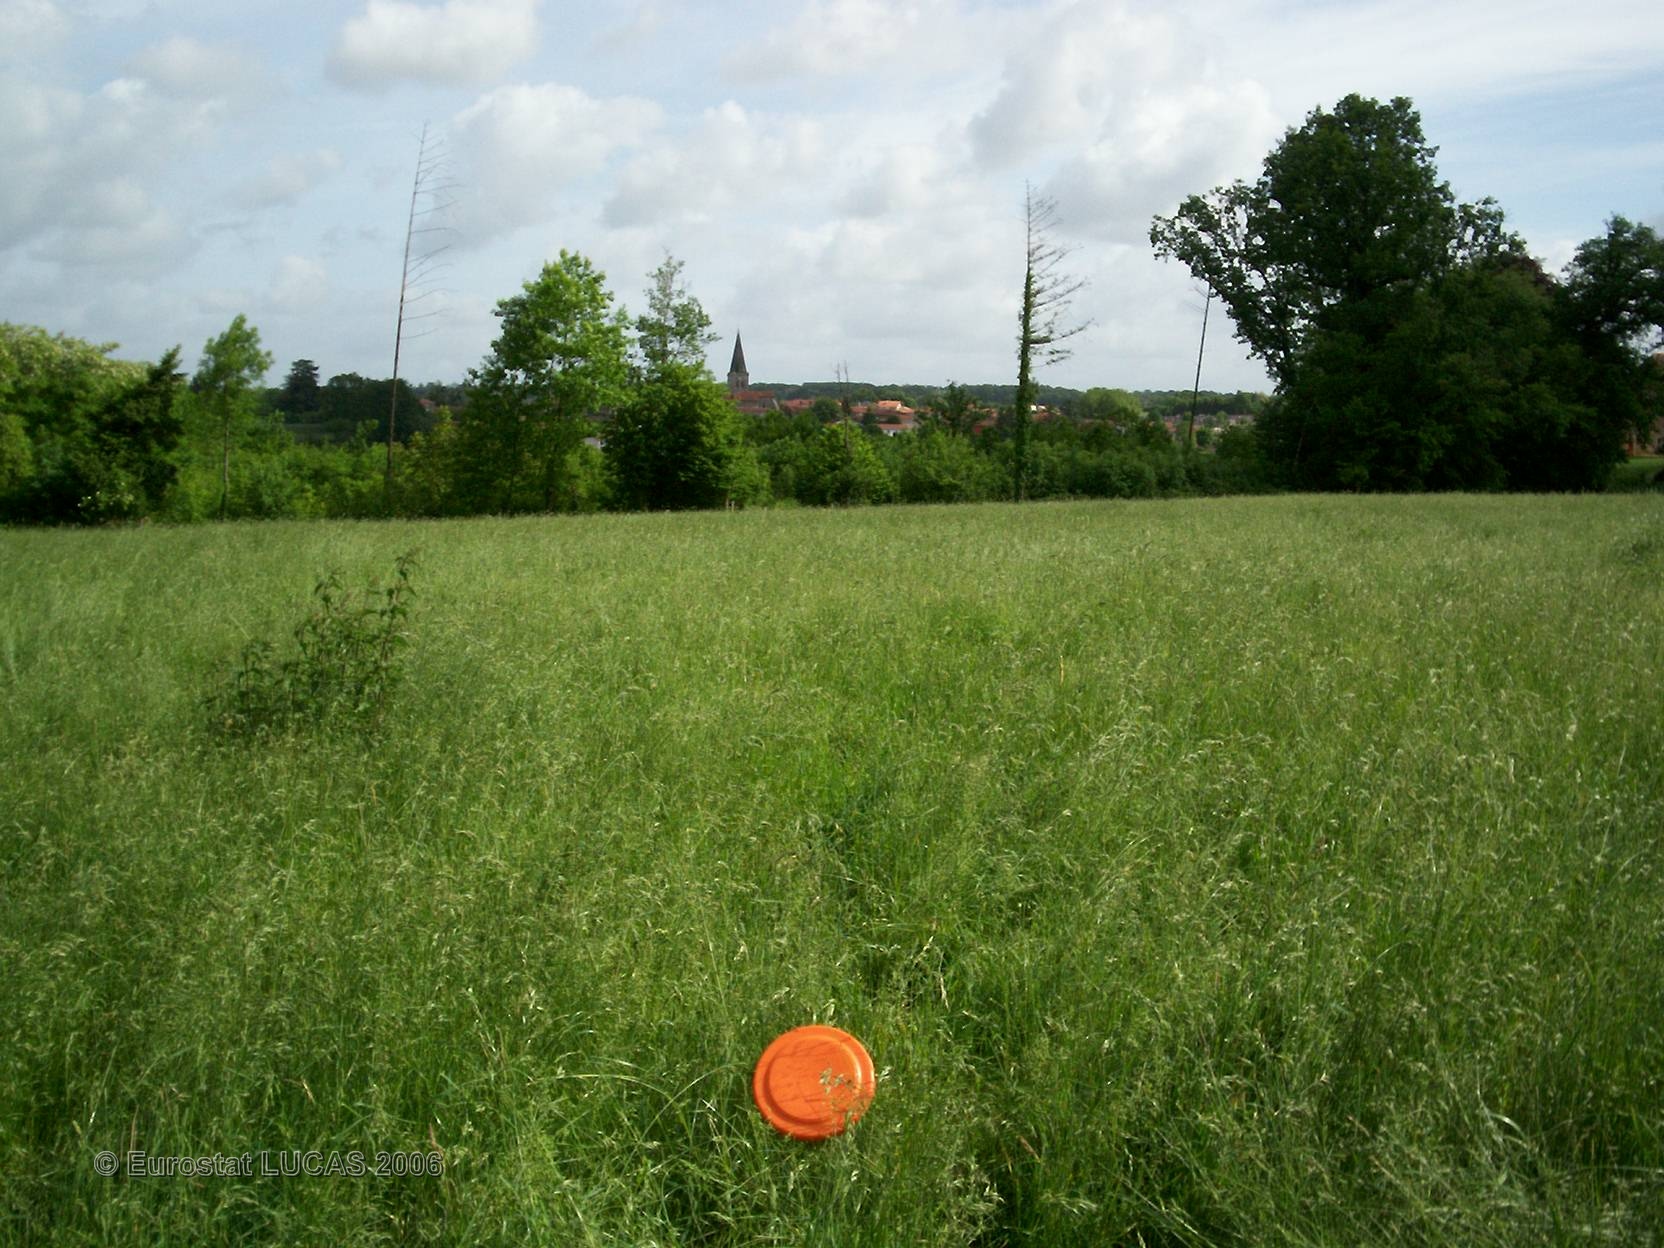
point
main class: Grassland
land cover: Grassland without tree/shrub cover
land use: Agriculture (excluding fallow land and kitchen gardens)
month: May
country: FR
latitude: 45.8878
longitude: 0.4619
